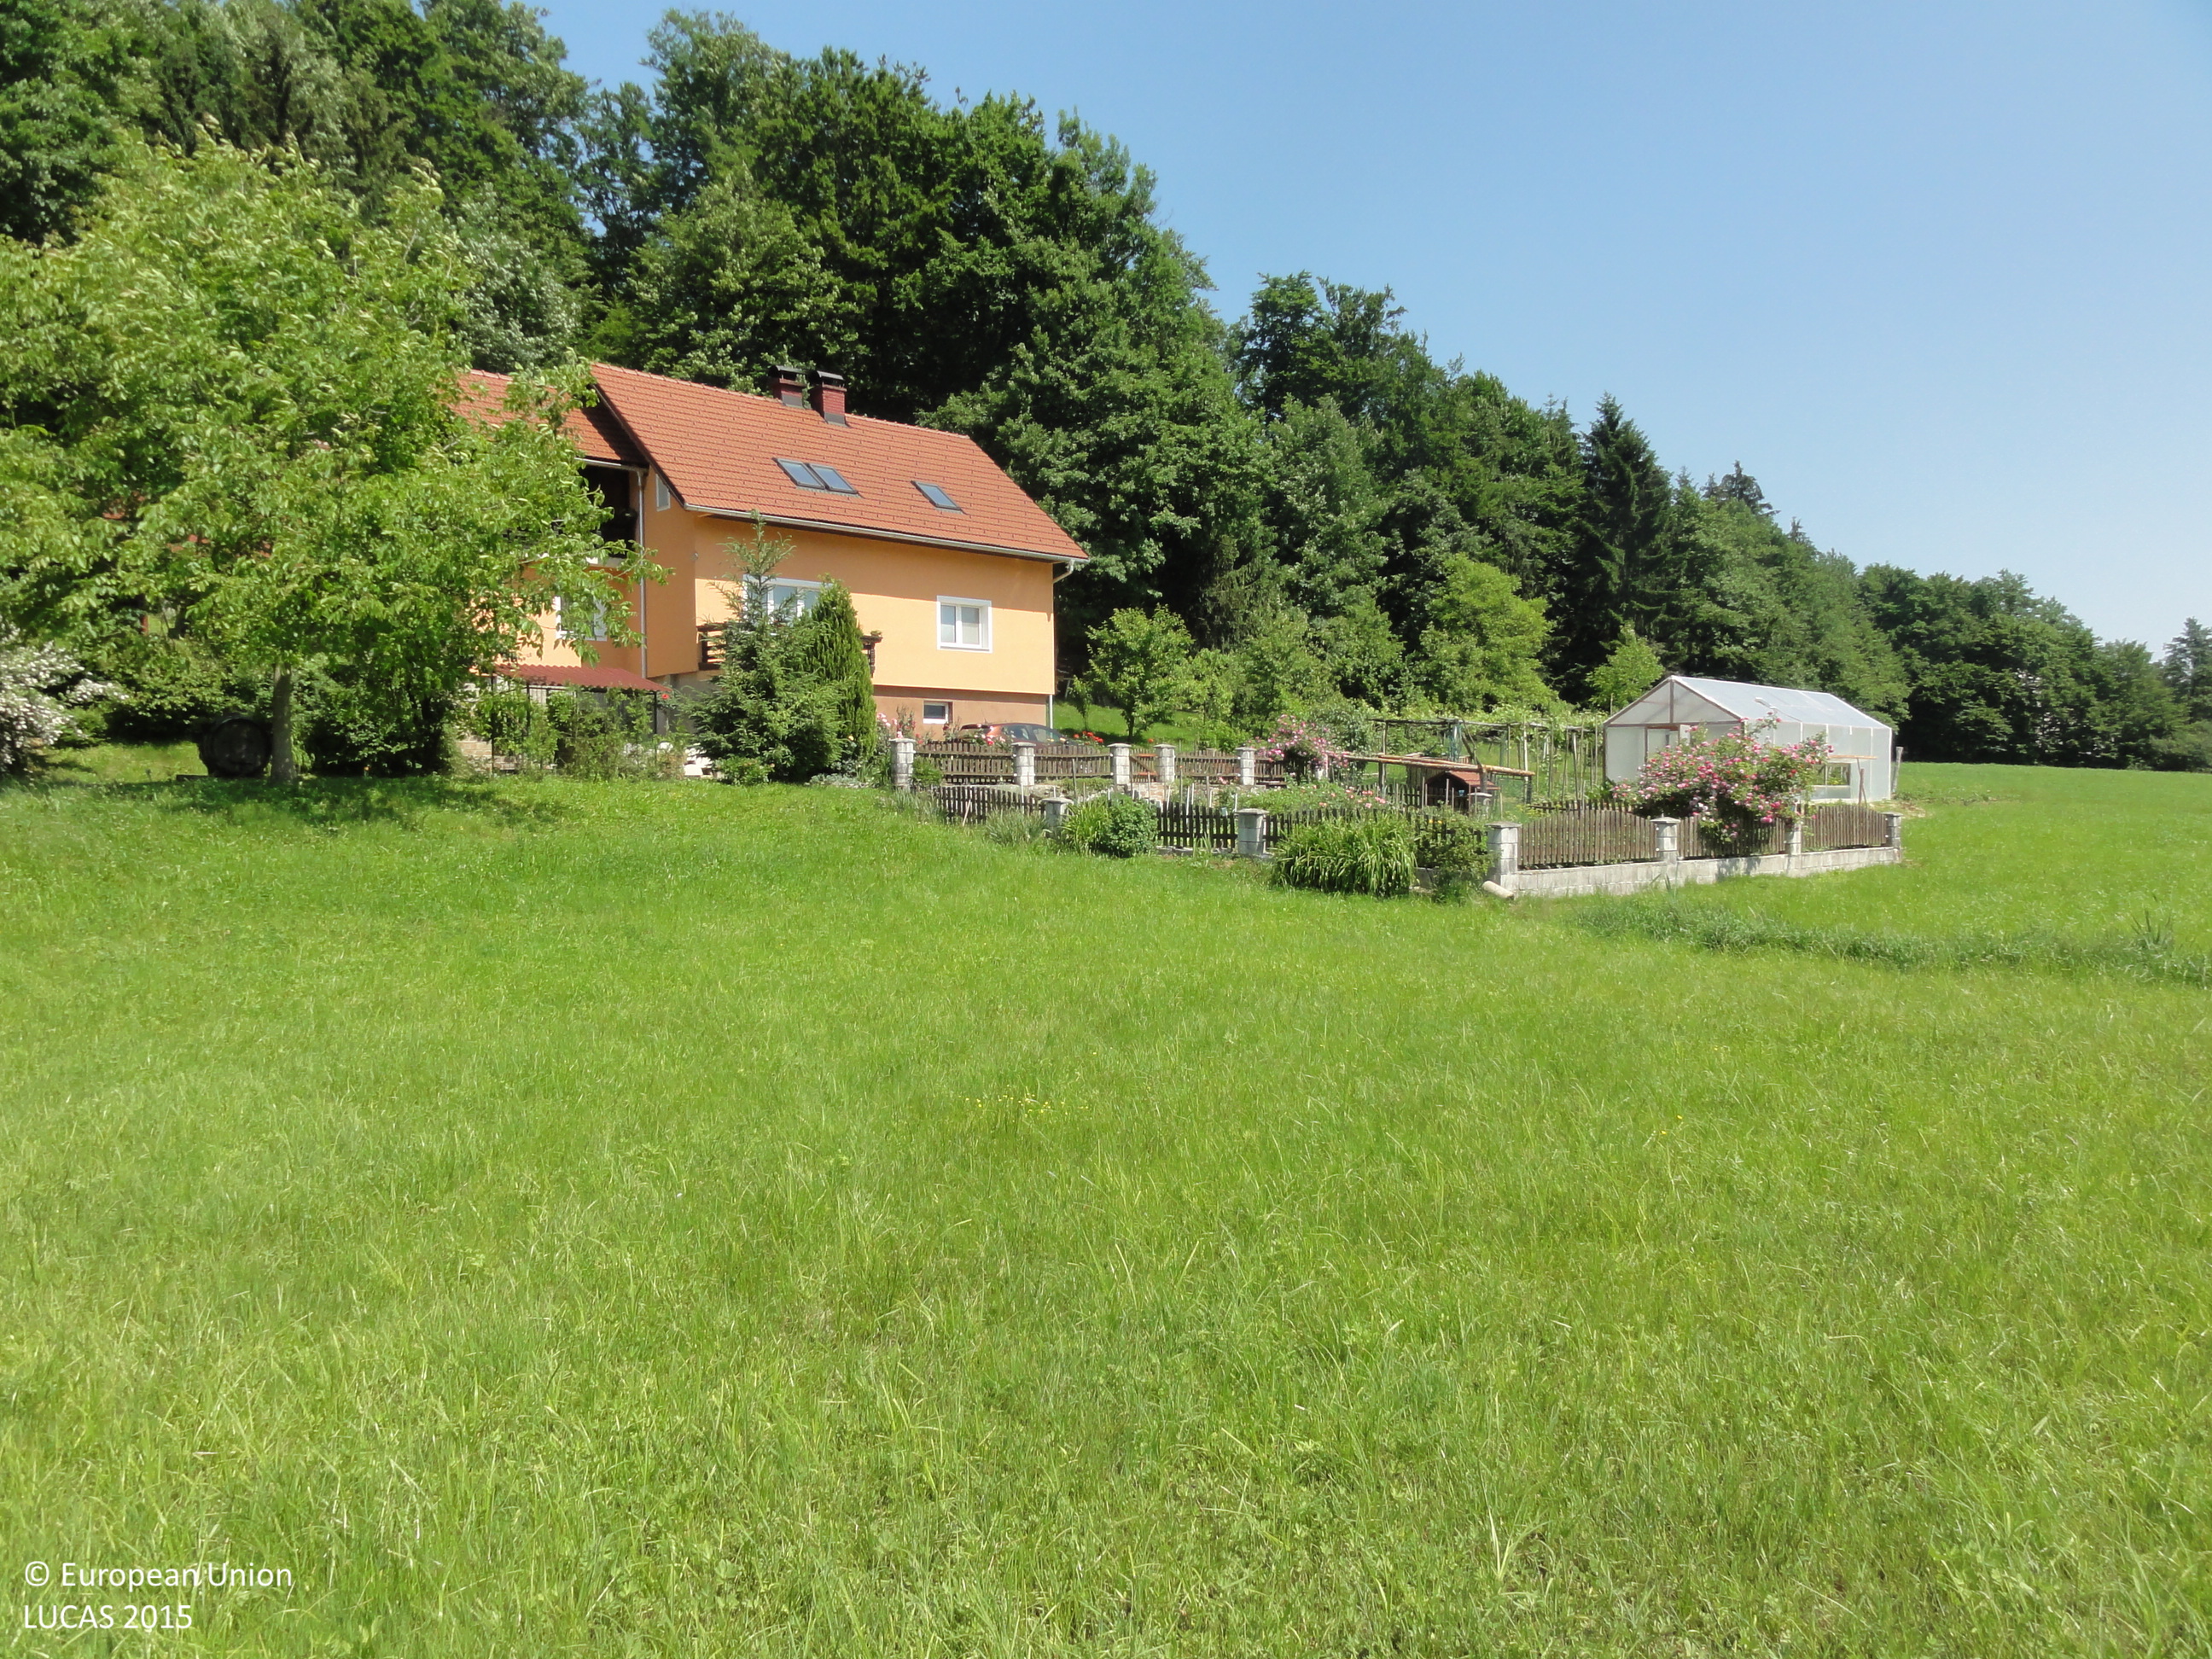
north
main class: Grassland
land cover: Grassland without tree/shrub cover
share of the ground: > 75 %
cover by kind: herbaceous plants 100 %
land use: Agriculture (excluding fallow land and kitchen gardens)
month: June
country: SI
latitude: 46.2992
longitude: 15.5158
